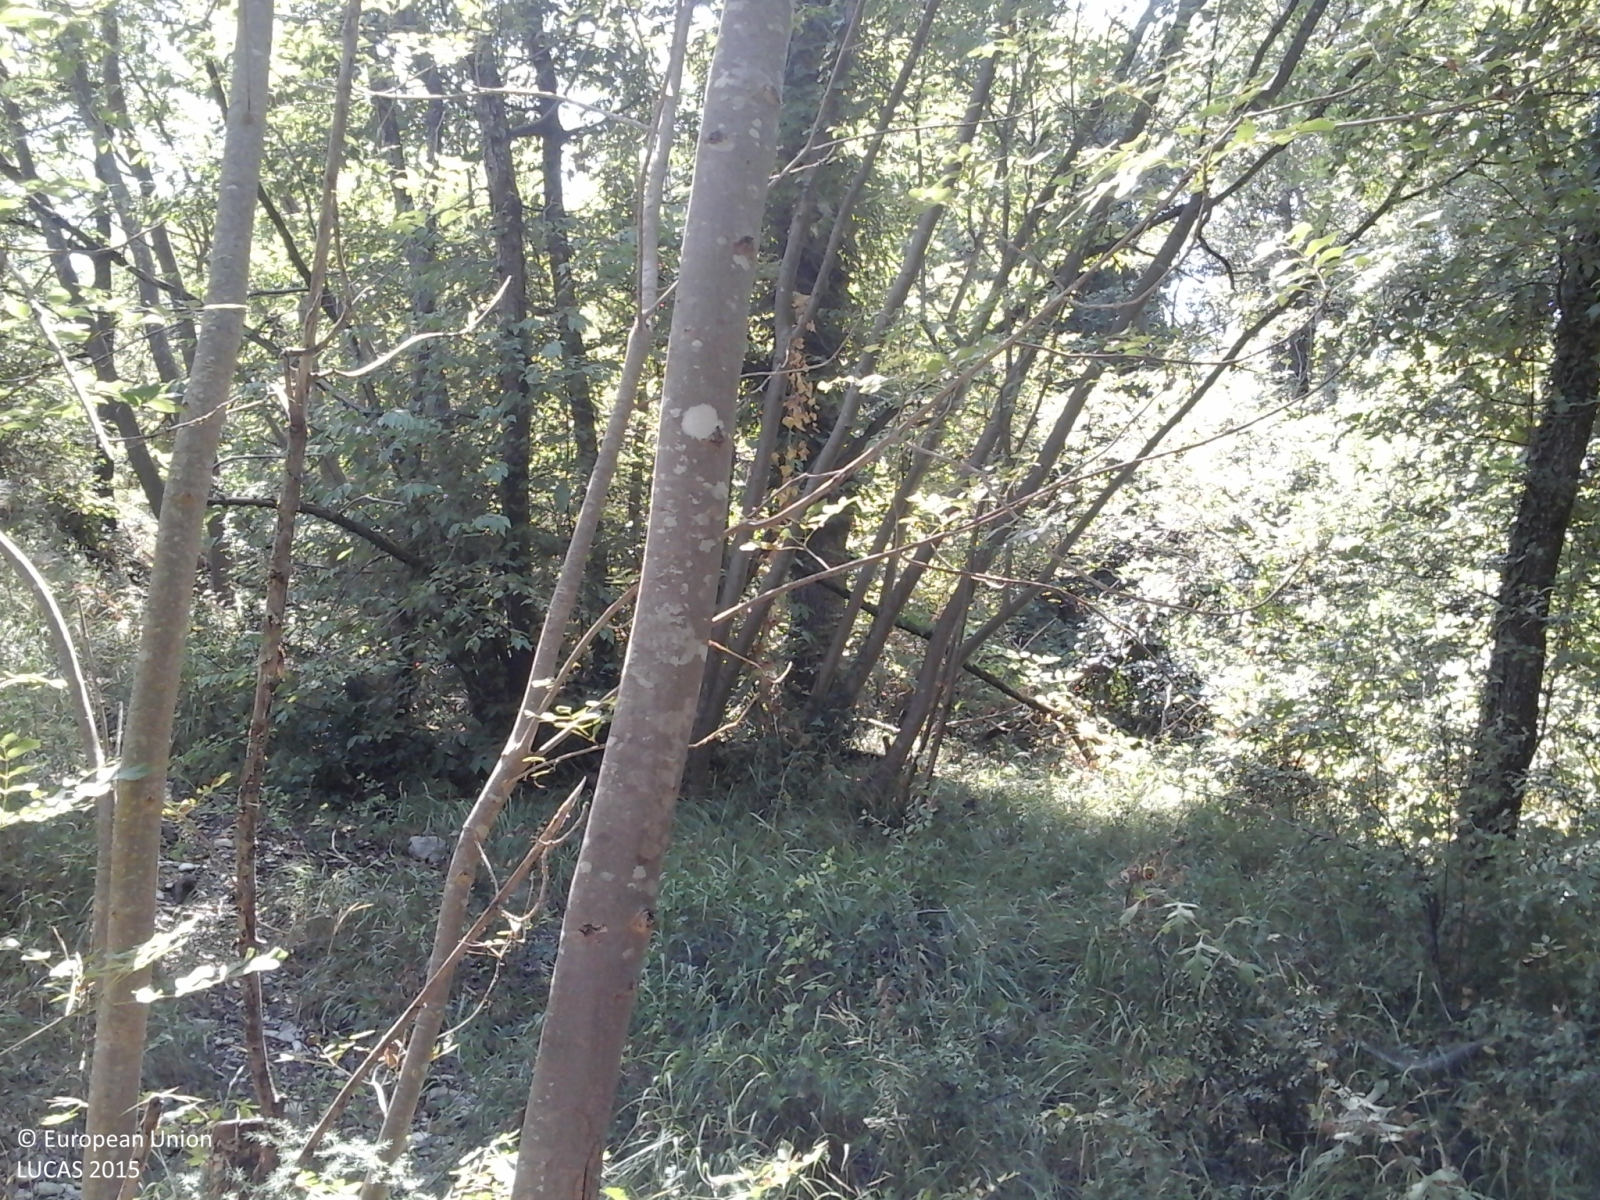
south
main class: Woodland
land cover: Broadleaved woodland
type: mesophytic deciduous forest
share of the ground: > 75 %
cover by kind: broadleaved forest trees 100 %
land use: Forestry
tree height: > 5 m
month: July
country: IT
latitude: 43.9450
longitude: 12.3492
